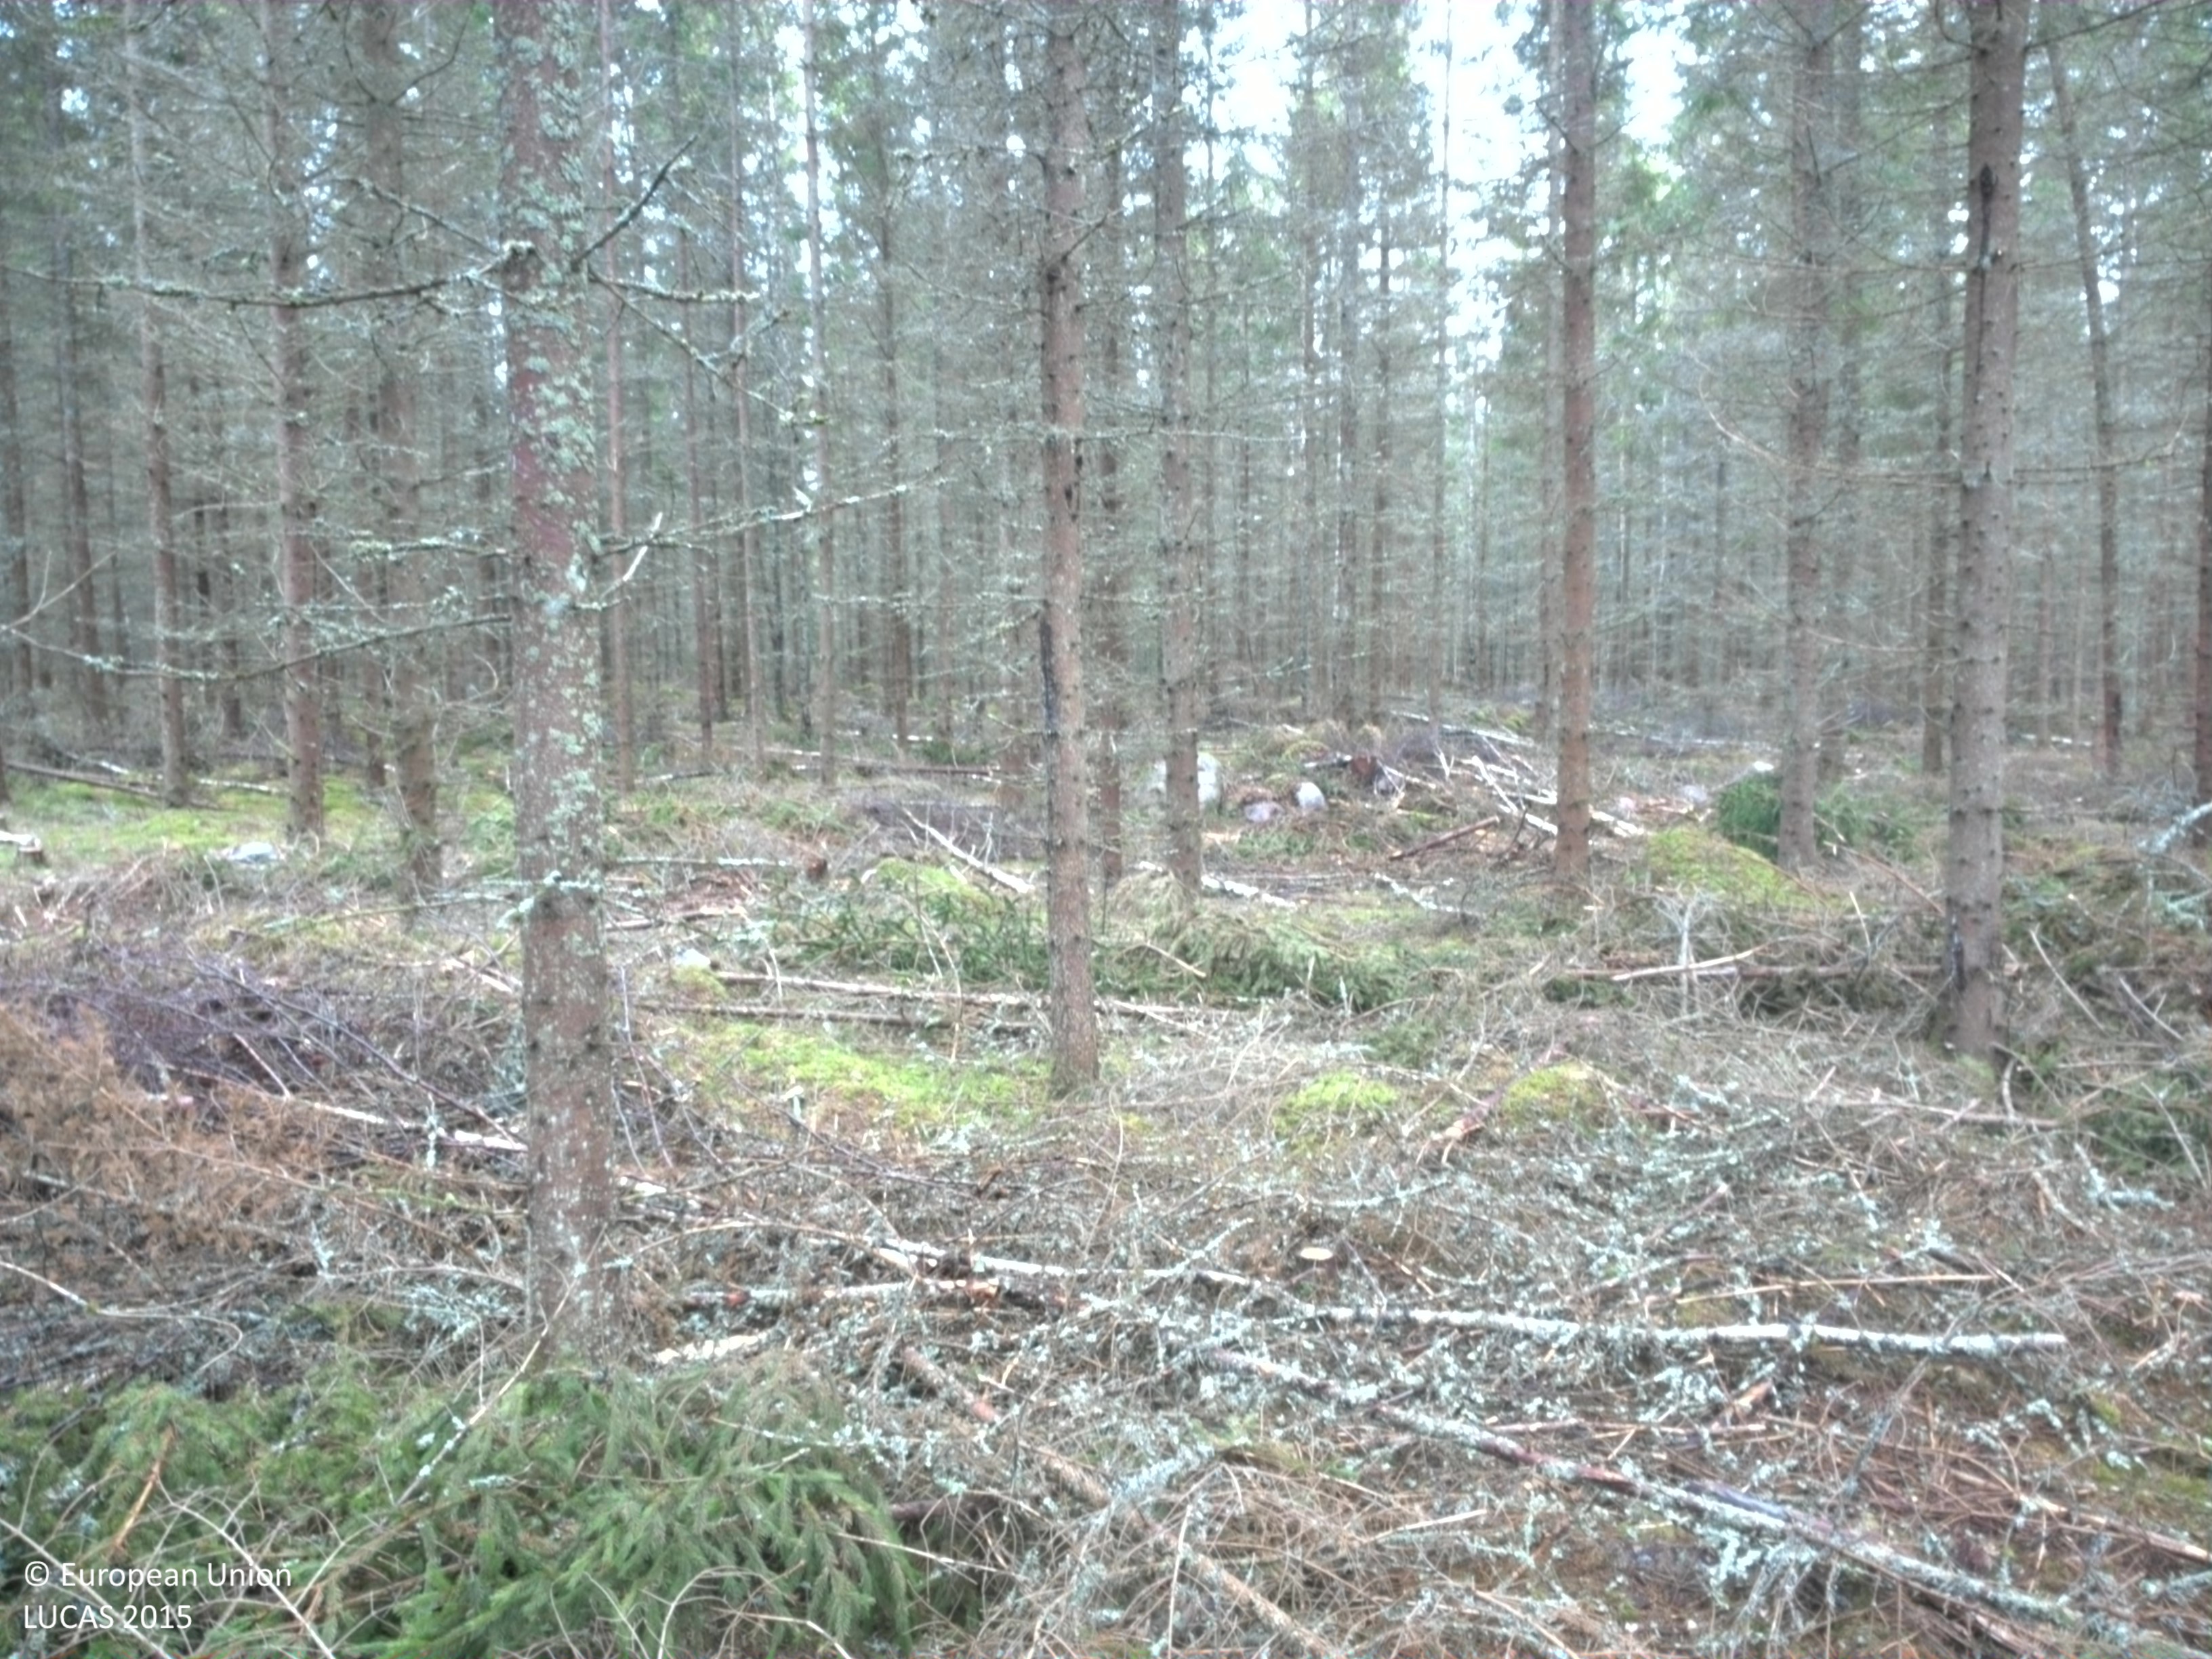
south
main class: Woodland
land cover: Spruce dominated coniferous woodland
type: boreal forest
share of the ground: > 75 %
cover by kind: coniferous forest trees 70 %, lichens and mosses 20 %, broadleaved forest trees 10 %
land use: Forestry
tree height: > 5 m
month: May
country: SE
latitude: 56.6103
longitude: 15.0650
